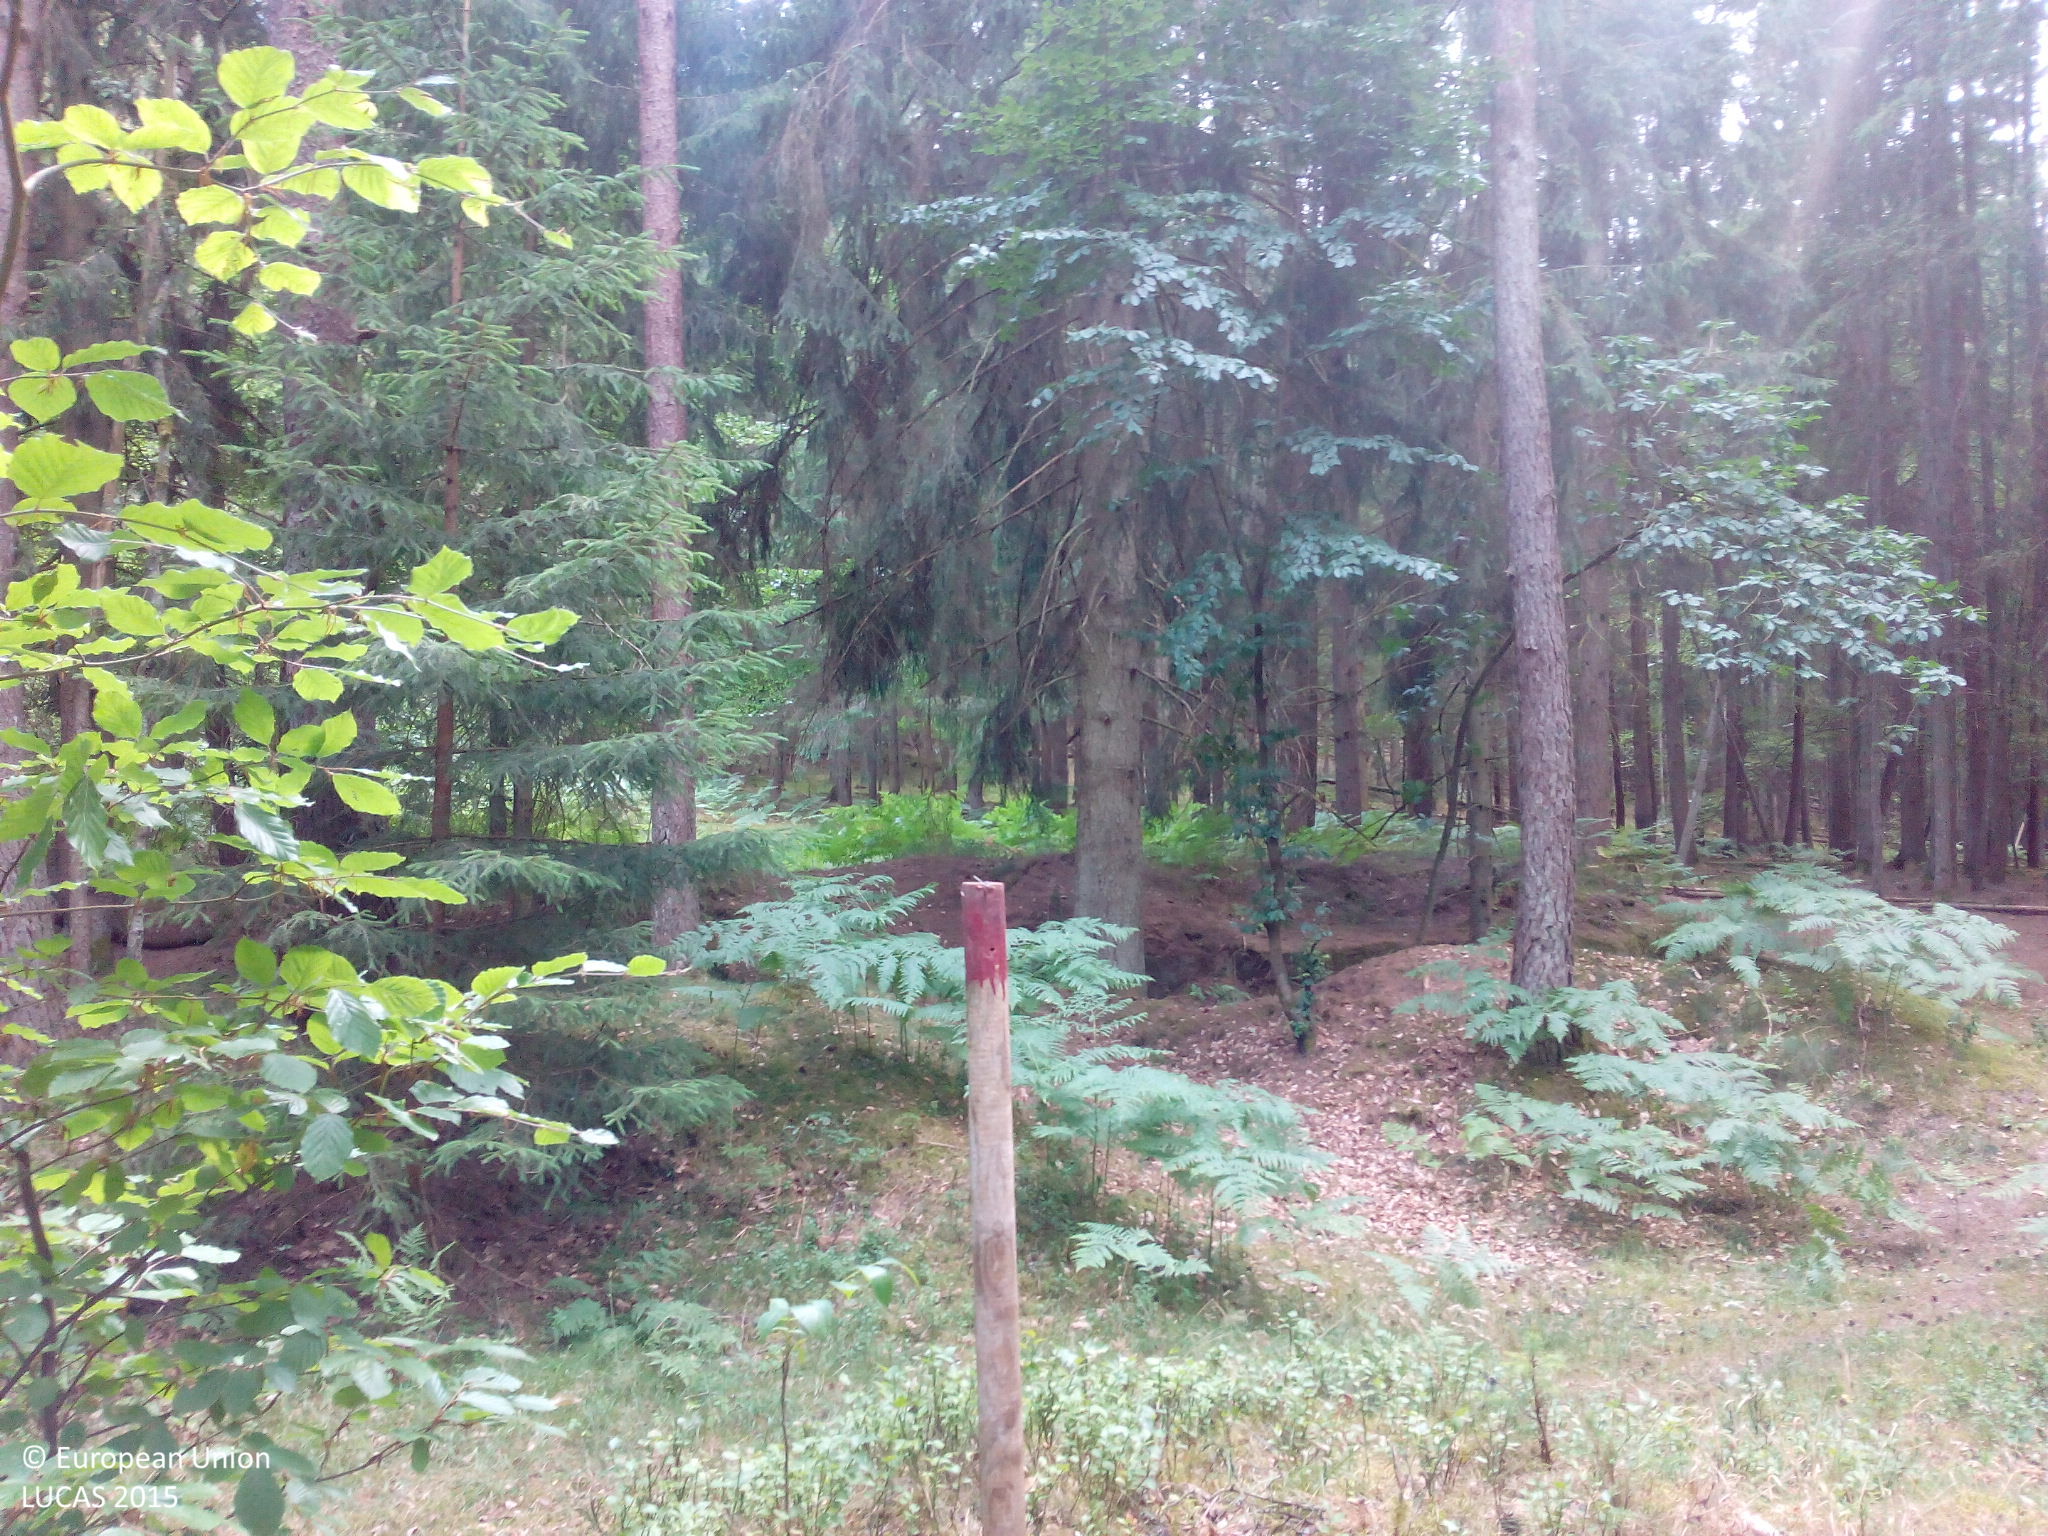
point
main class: Woodland
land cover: Other coniferous woodland
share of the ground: > 75 %
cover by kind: coniferous forest trees 70 %, broadleaved forest trees 15 %, shrubs 5 %, herbaceous plants 5 %, unconsolidated bare surface 5 %
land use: Forestry
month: July
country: DE
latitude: 49.1143
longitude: 7.5482
